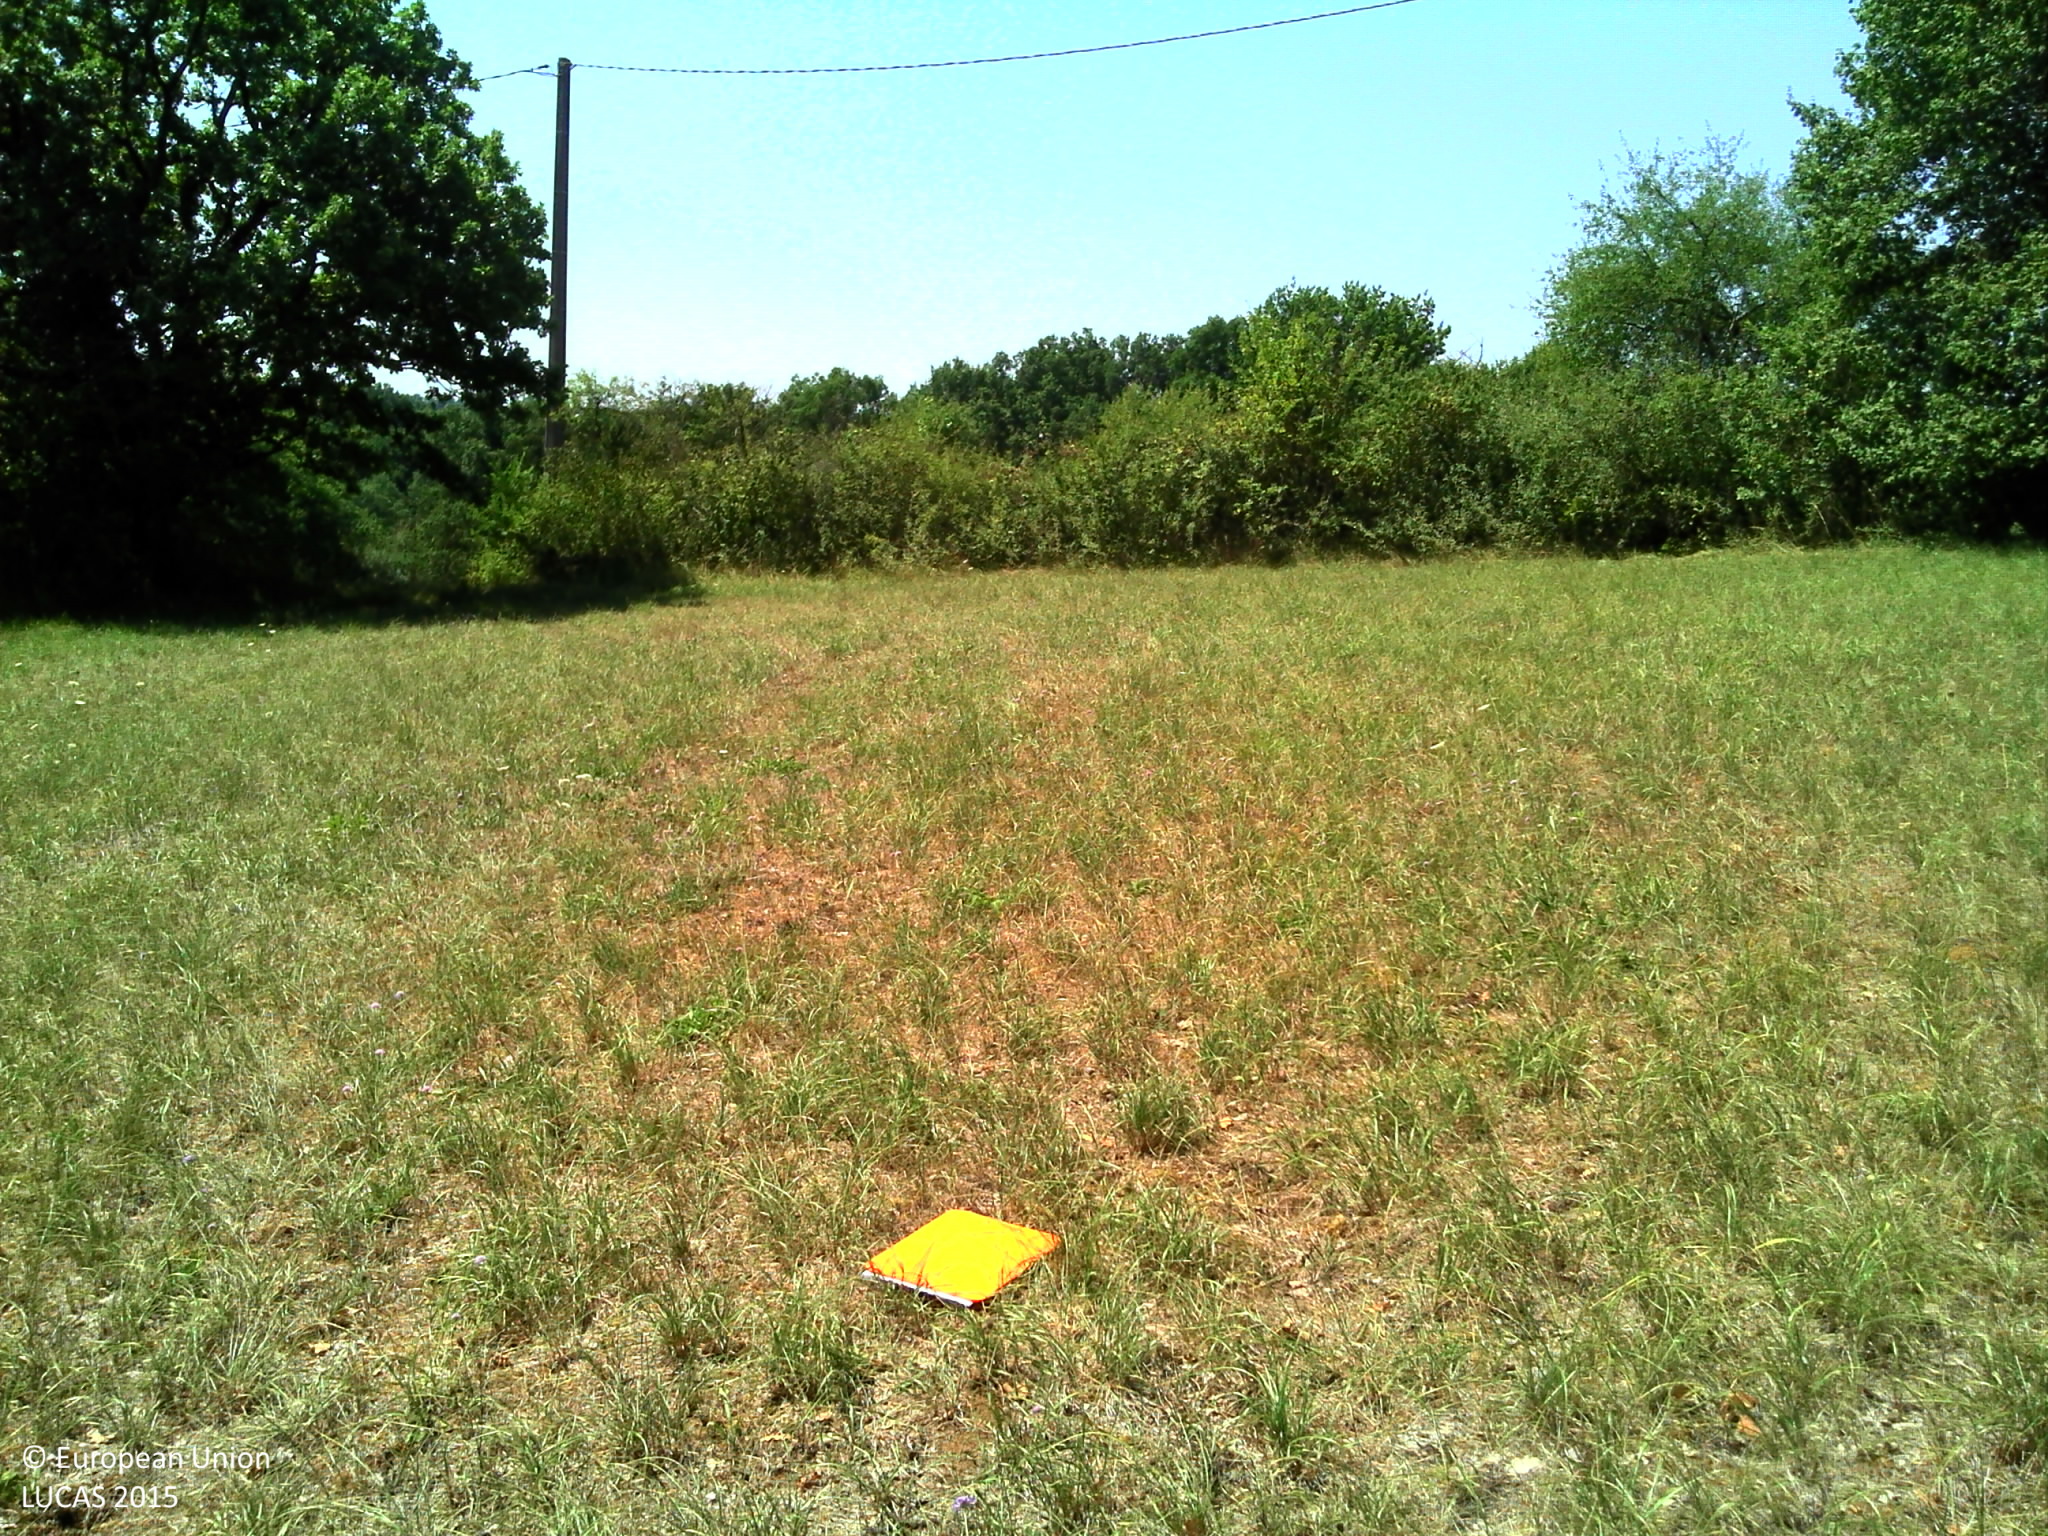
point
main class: Grassland
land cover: Grassland without tree/shrub cover
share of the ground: > 75 %
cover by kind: herbaceous plants 100 %
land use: Agriculture (excluding fallow land and kitchen gardens)
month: August
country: FR
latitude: 44.7604
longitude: 0.8339
